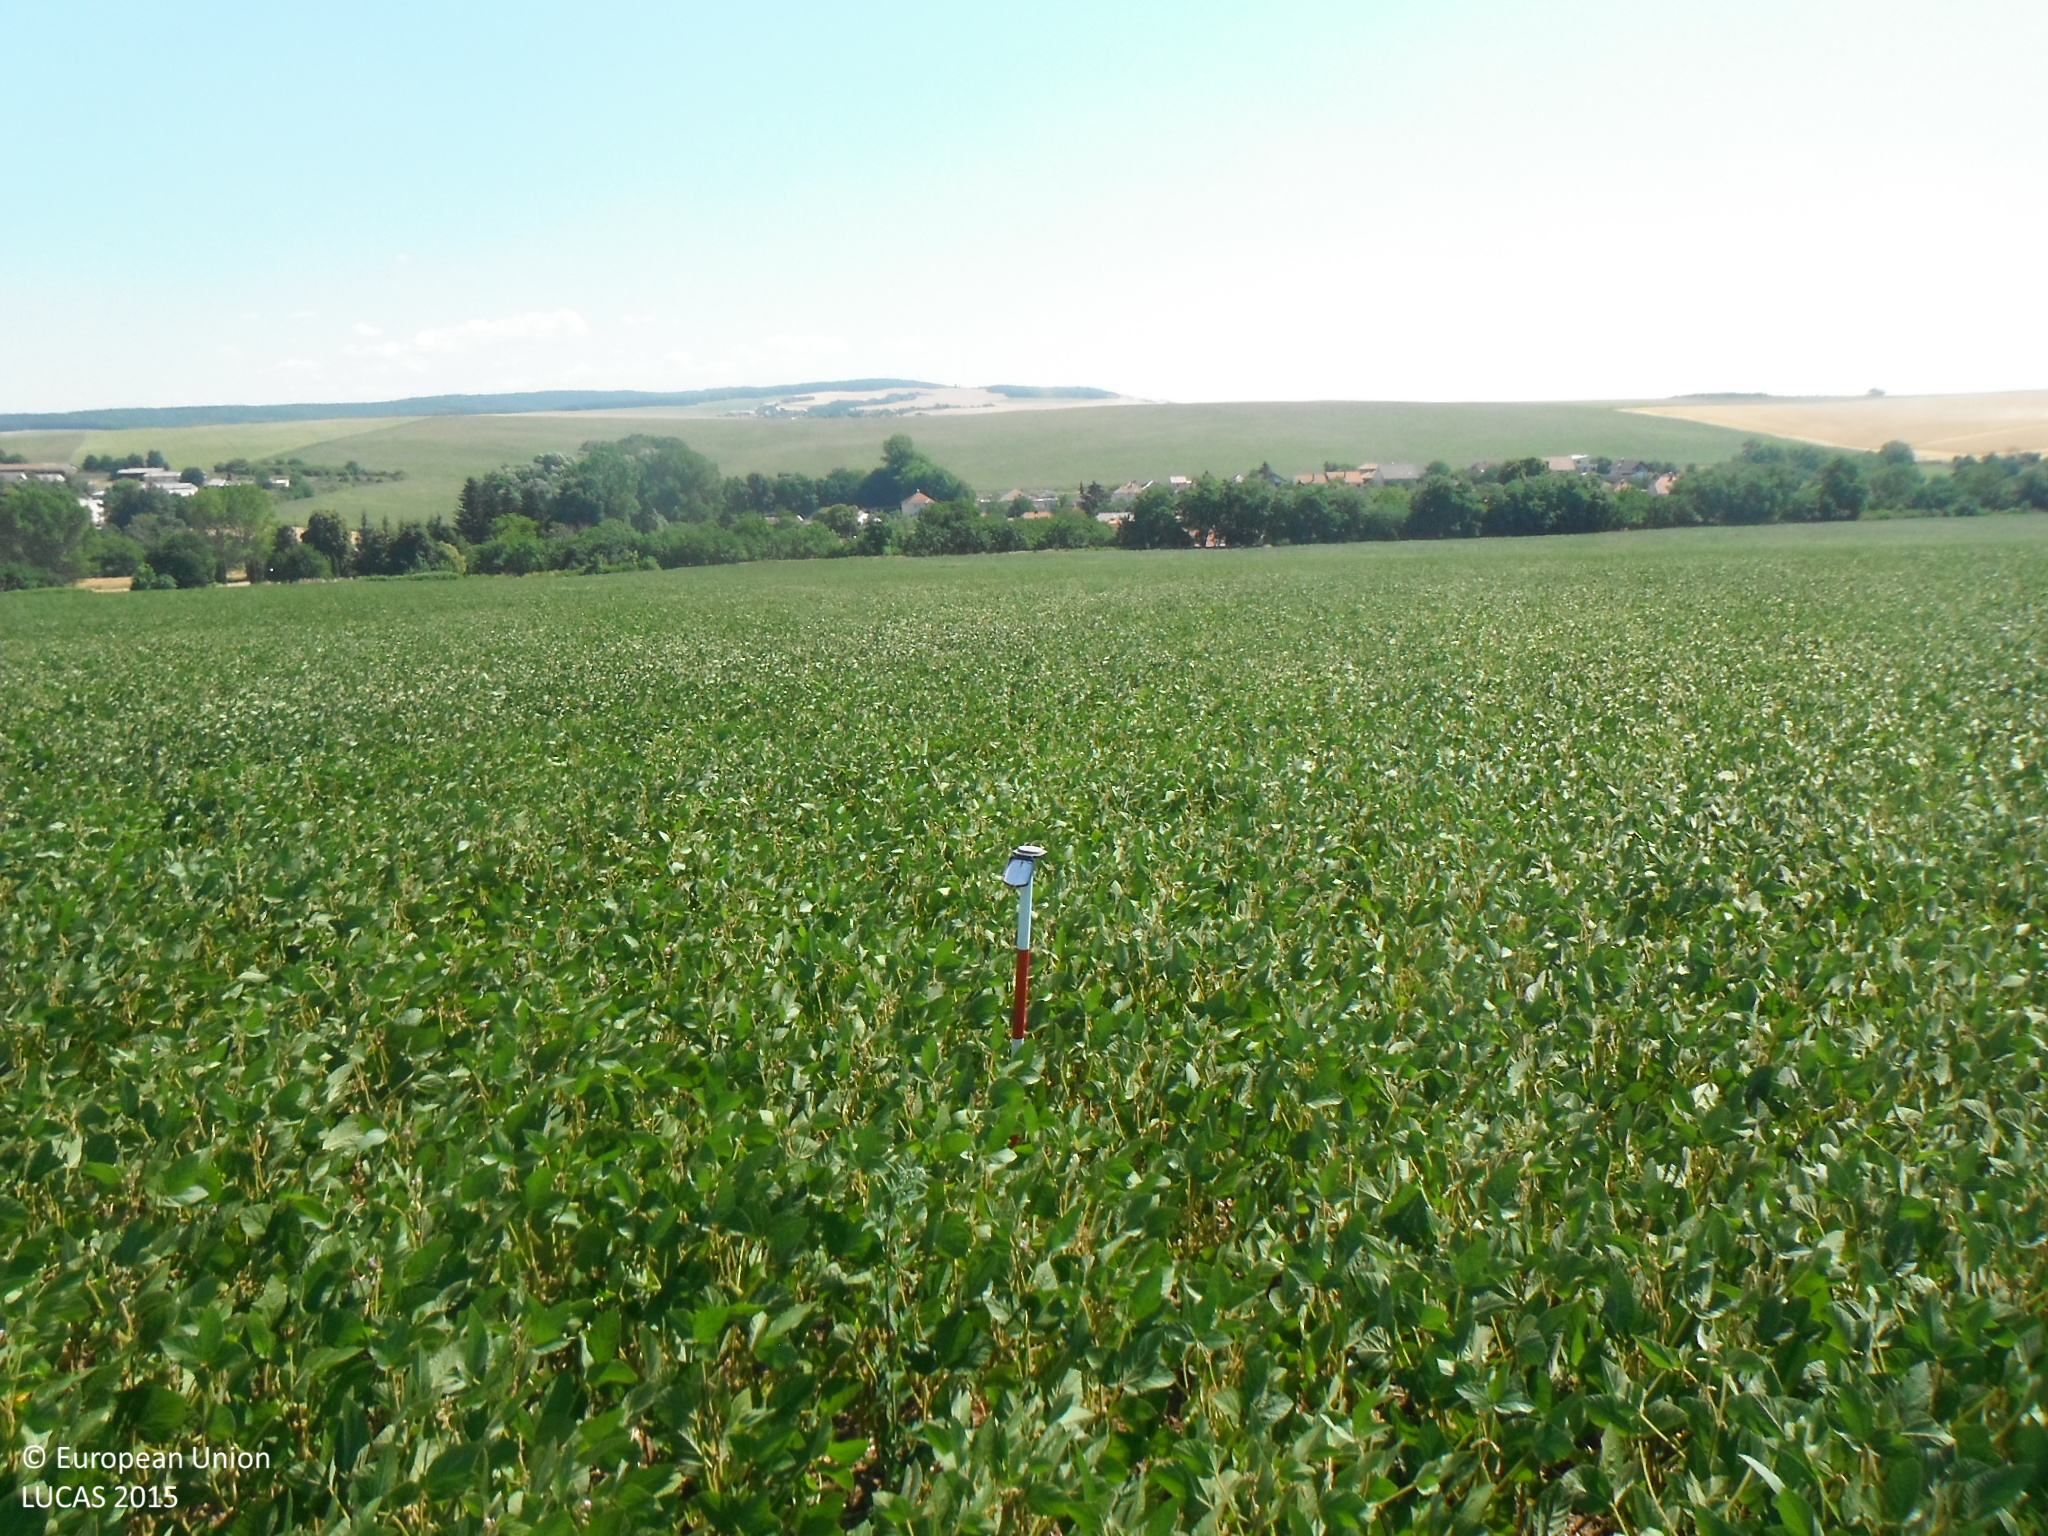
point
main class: Cropland
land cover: Soya
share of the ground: > 75 %
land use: Agriculture (excluding fallow land and kitchen gardens)
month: July
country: SK
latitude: 48.7124
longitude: 17.1716
